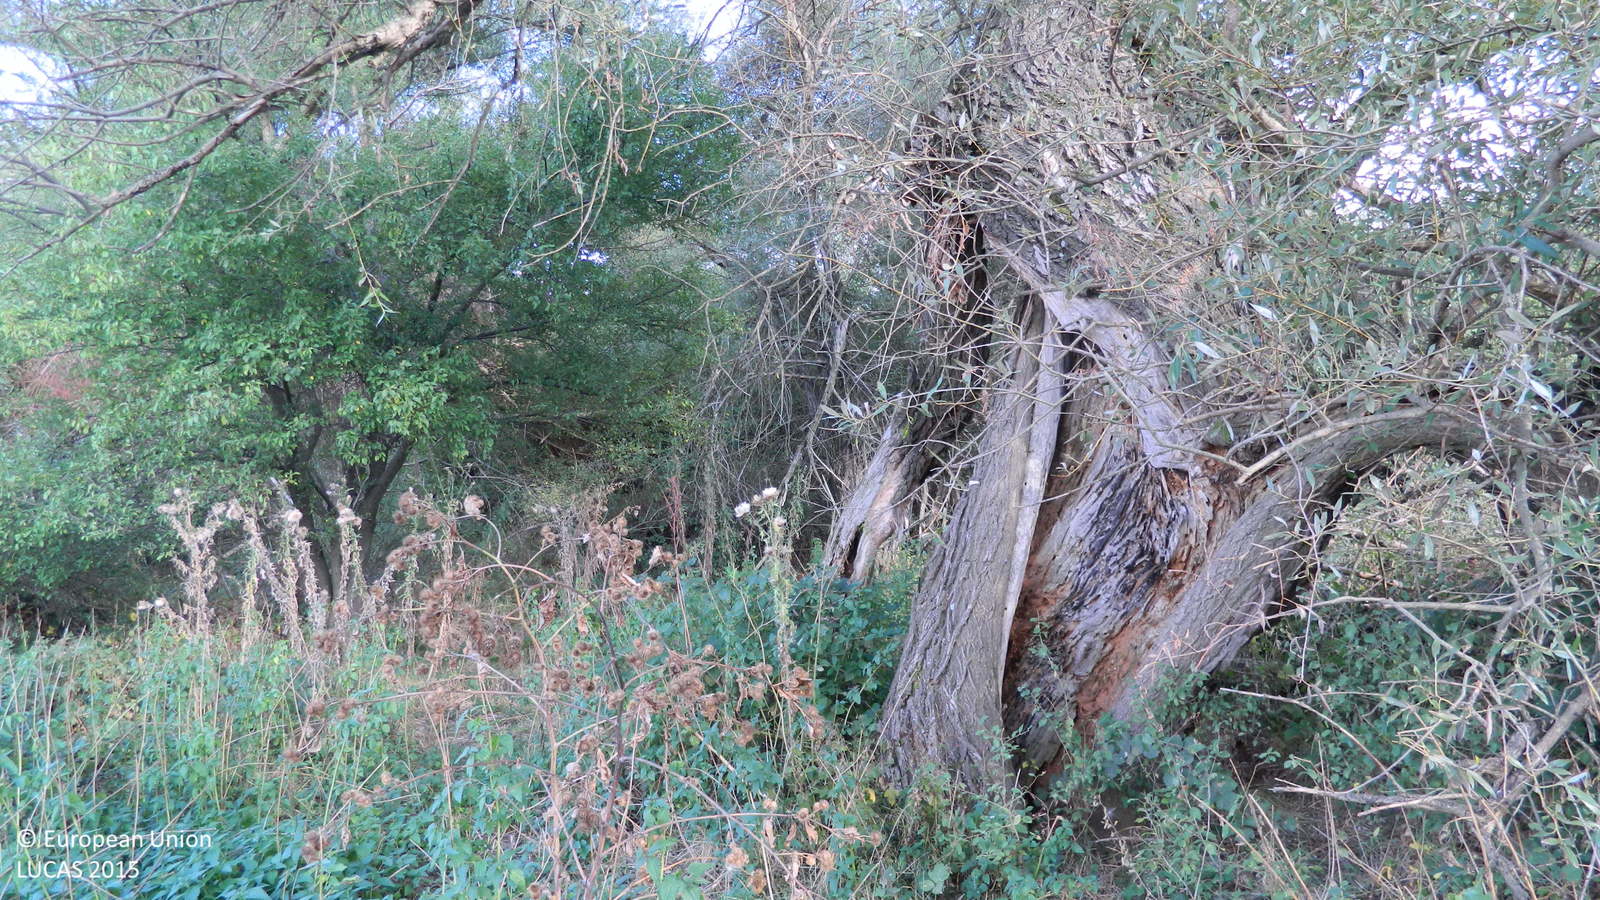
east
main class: Shrubland
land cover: Shrubland with sparse tree cover
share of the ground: > 75 %
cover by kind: shrubs 95 %, broadleaved forest trees 5 %
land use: Semi-natural and natural areas not in use
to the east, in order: Shrubland with sparse tree cover; Tracks; Grassland with sparse tree/shrub cover; Shrubland with sparse tree cover; Other bare soil; Grass margins; Tracks; Grass margins; Shrubland with sparse tree cover; Other bare soil
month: September
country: BG
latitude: 41.7598
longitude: 25.7624
